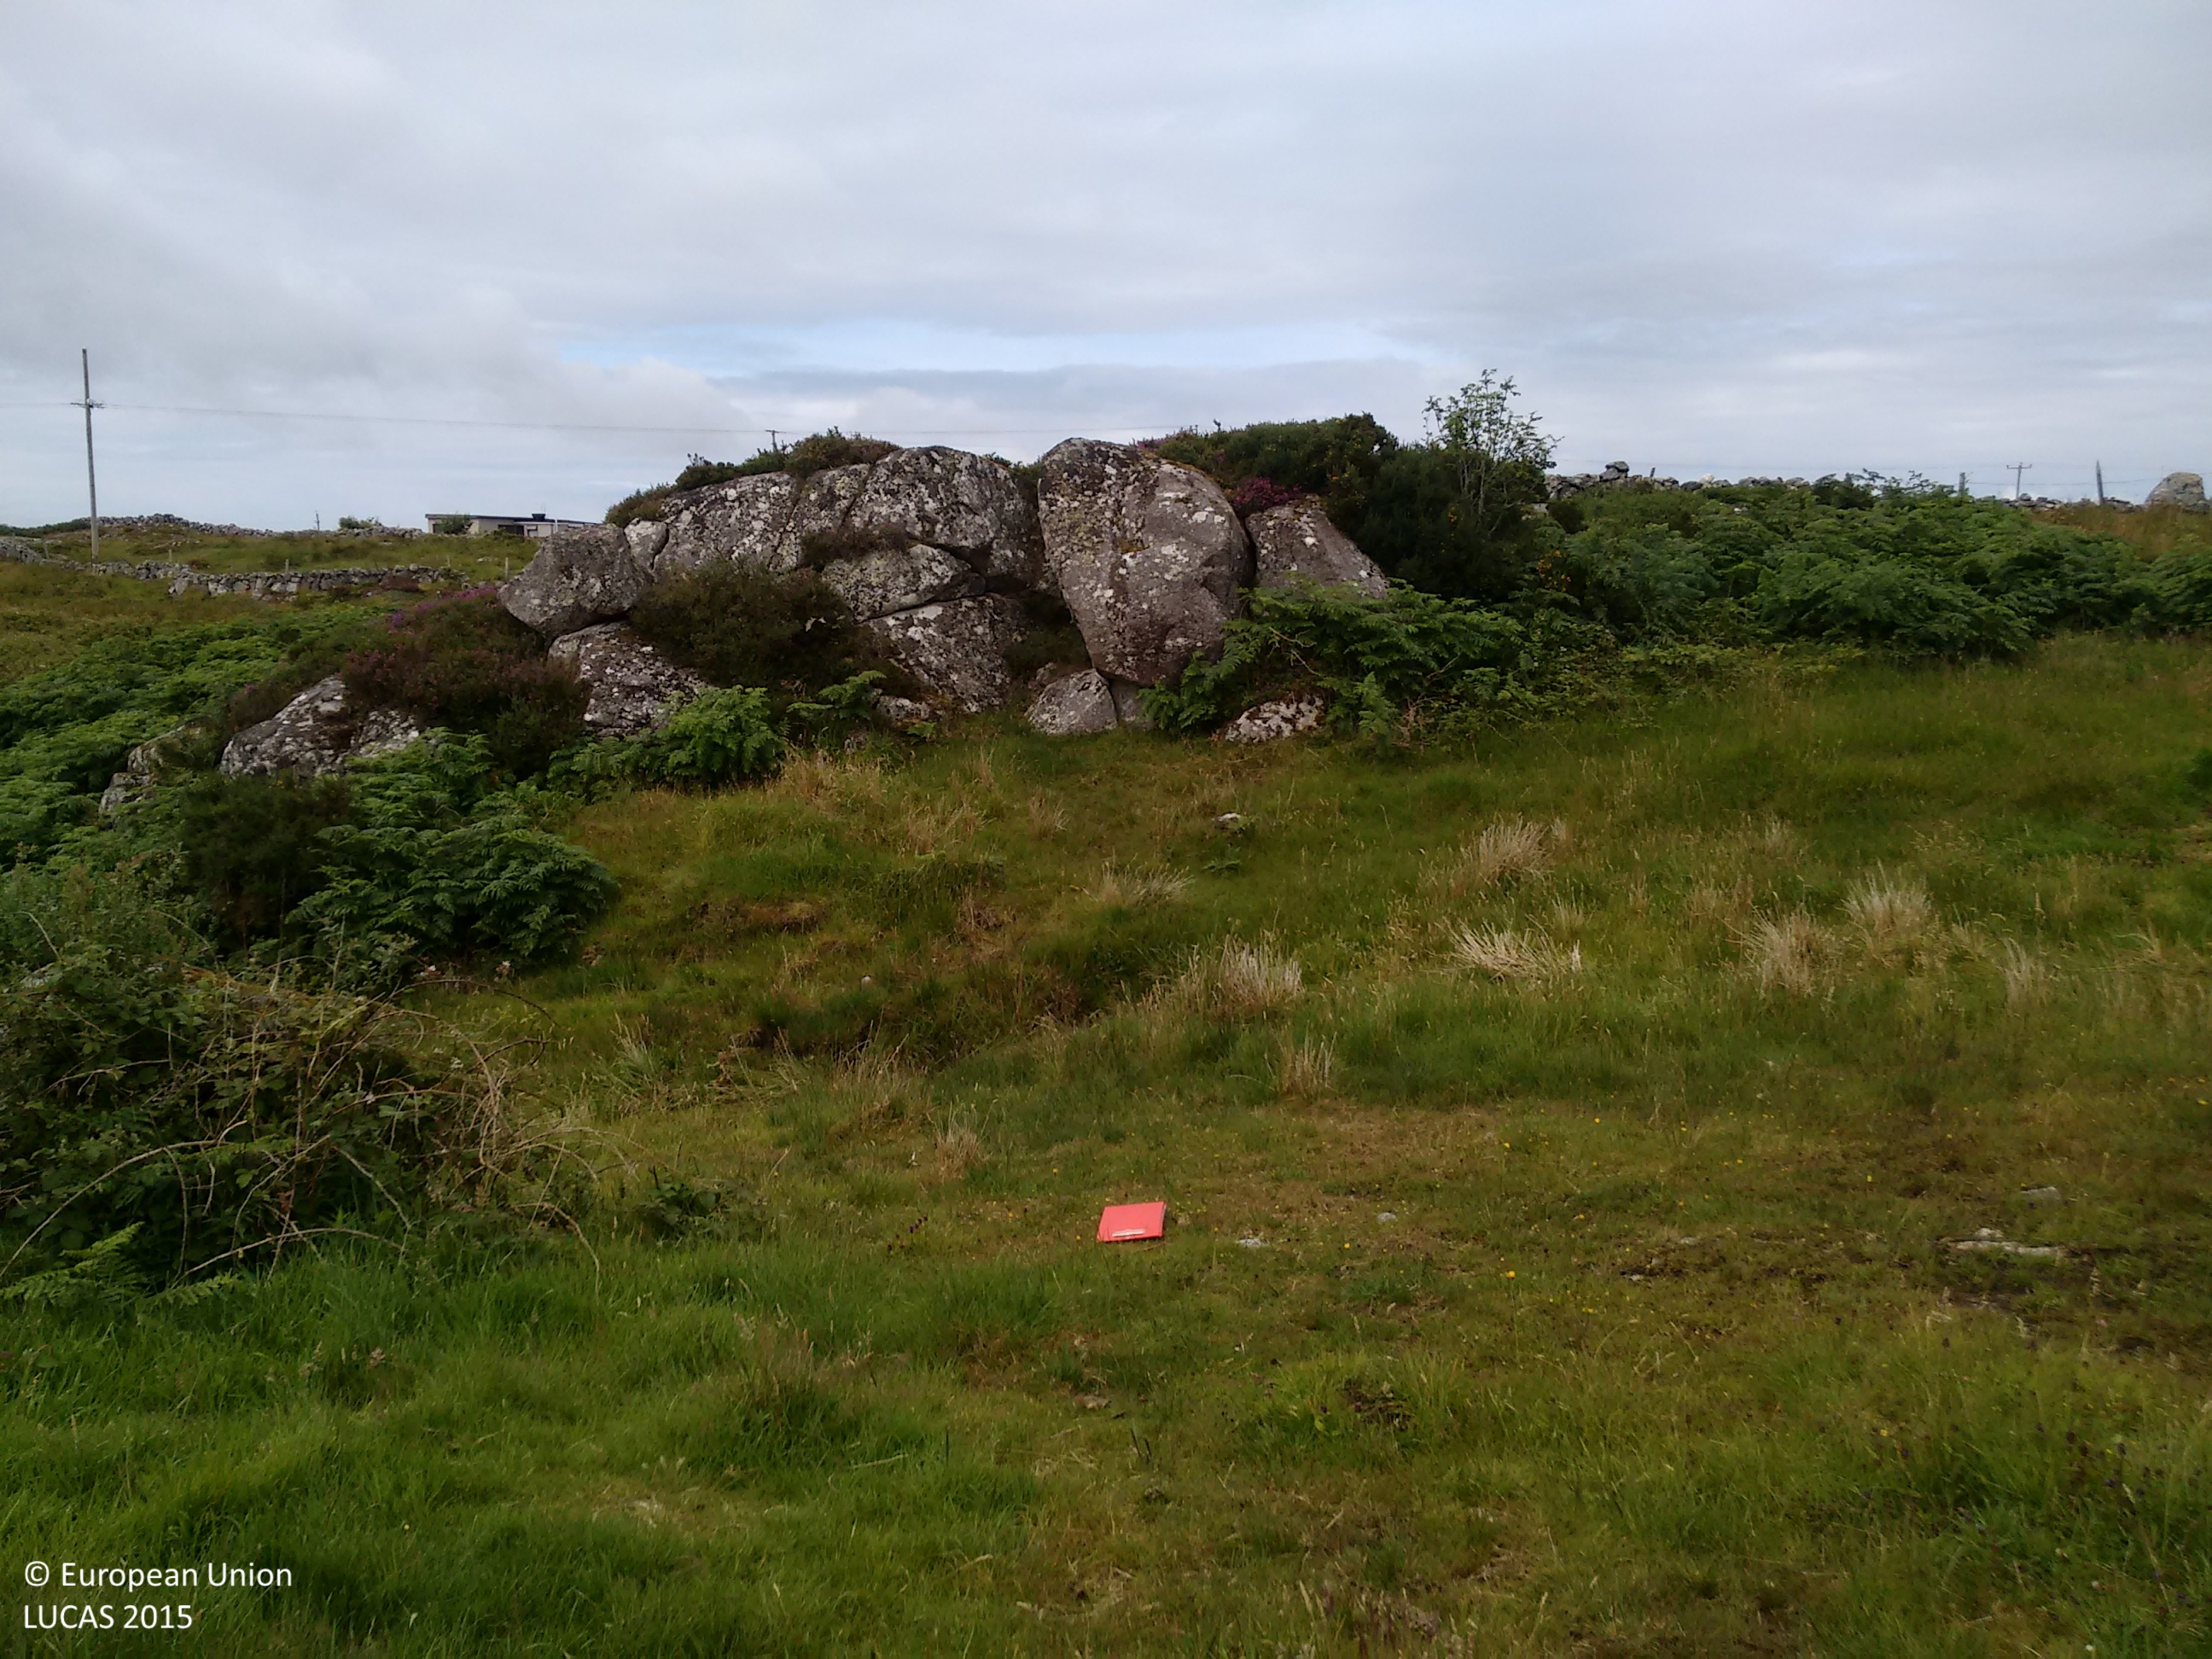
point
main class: Grassland
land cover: Grassland with sparse tree/shrub cover
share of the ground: 50 - 75 %
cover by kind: herbaceous plants 85 %, shrubs 10 %, broadleaved forest trees 5 %
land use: Agriculture (excluding fallow land and kitchen gardens)
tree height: < 5 m
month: July
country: IE
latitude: 53.2879
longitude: -9.5403
